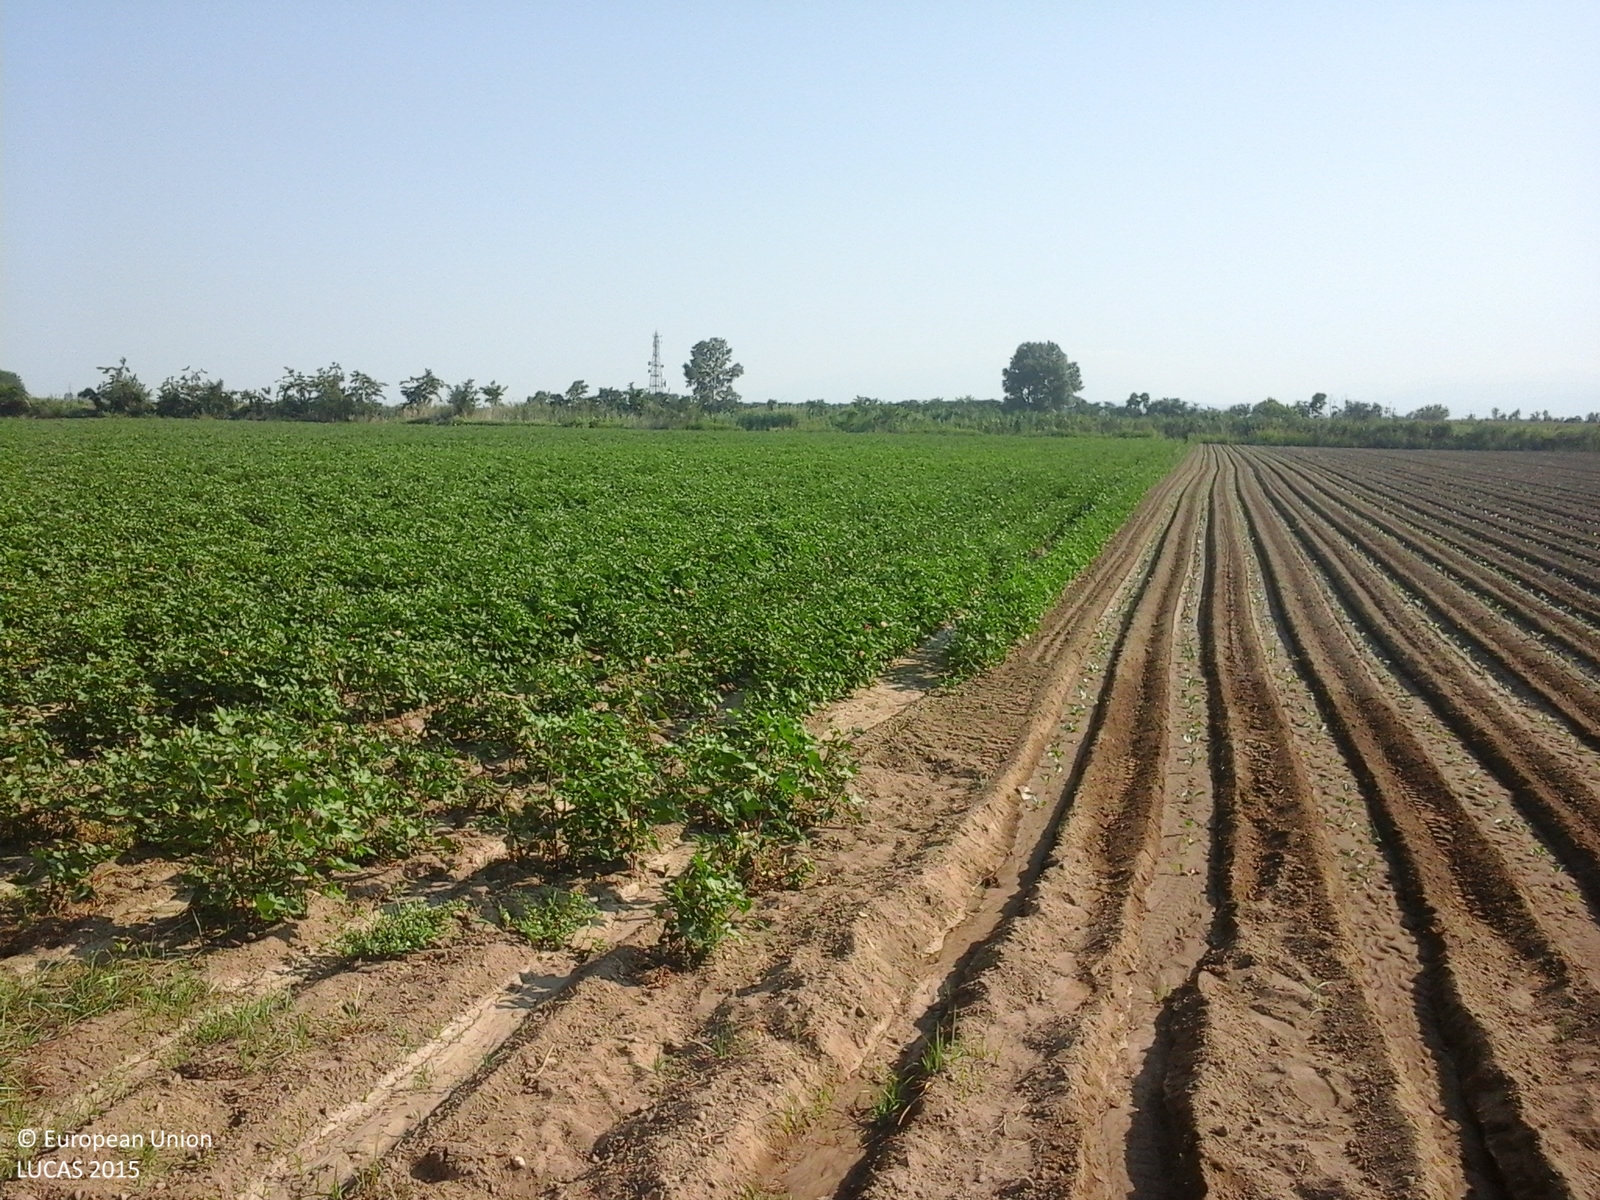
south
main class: Cropland
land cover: Other fresh vegetables
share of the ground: > 75 %
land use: Agriculture (excluding fallow land and kitchen gardens)
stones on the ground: < 10 %
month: July
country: GR
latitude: 40.7146
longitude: 22.5874
